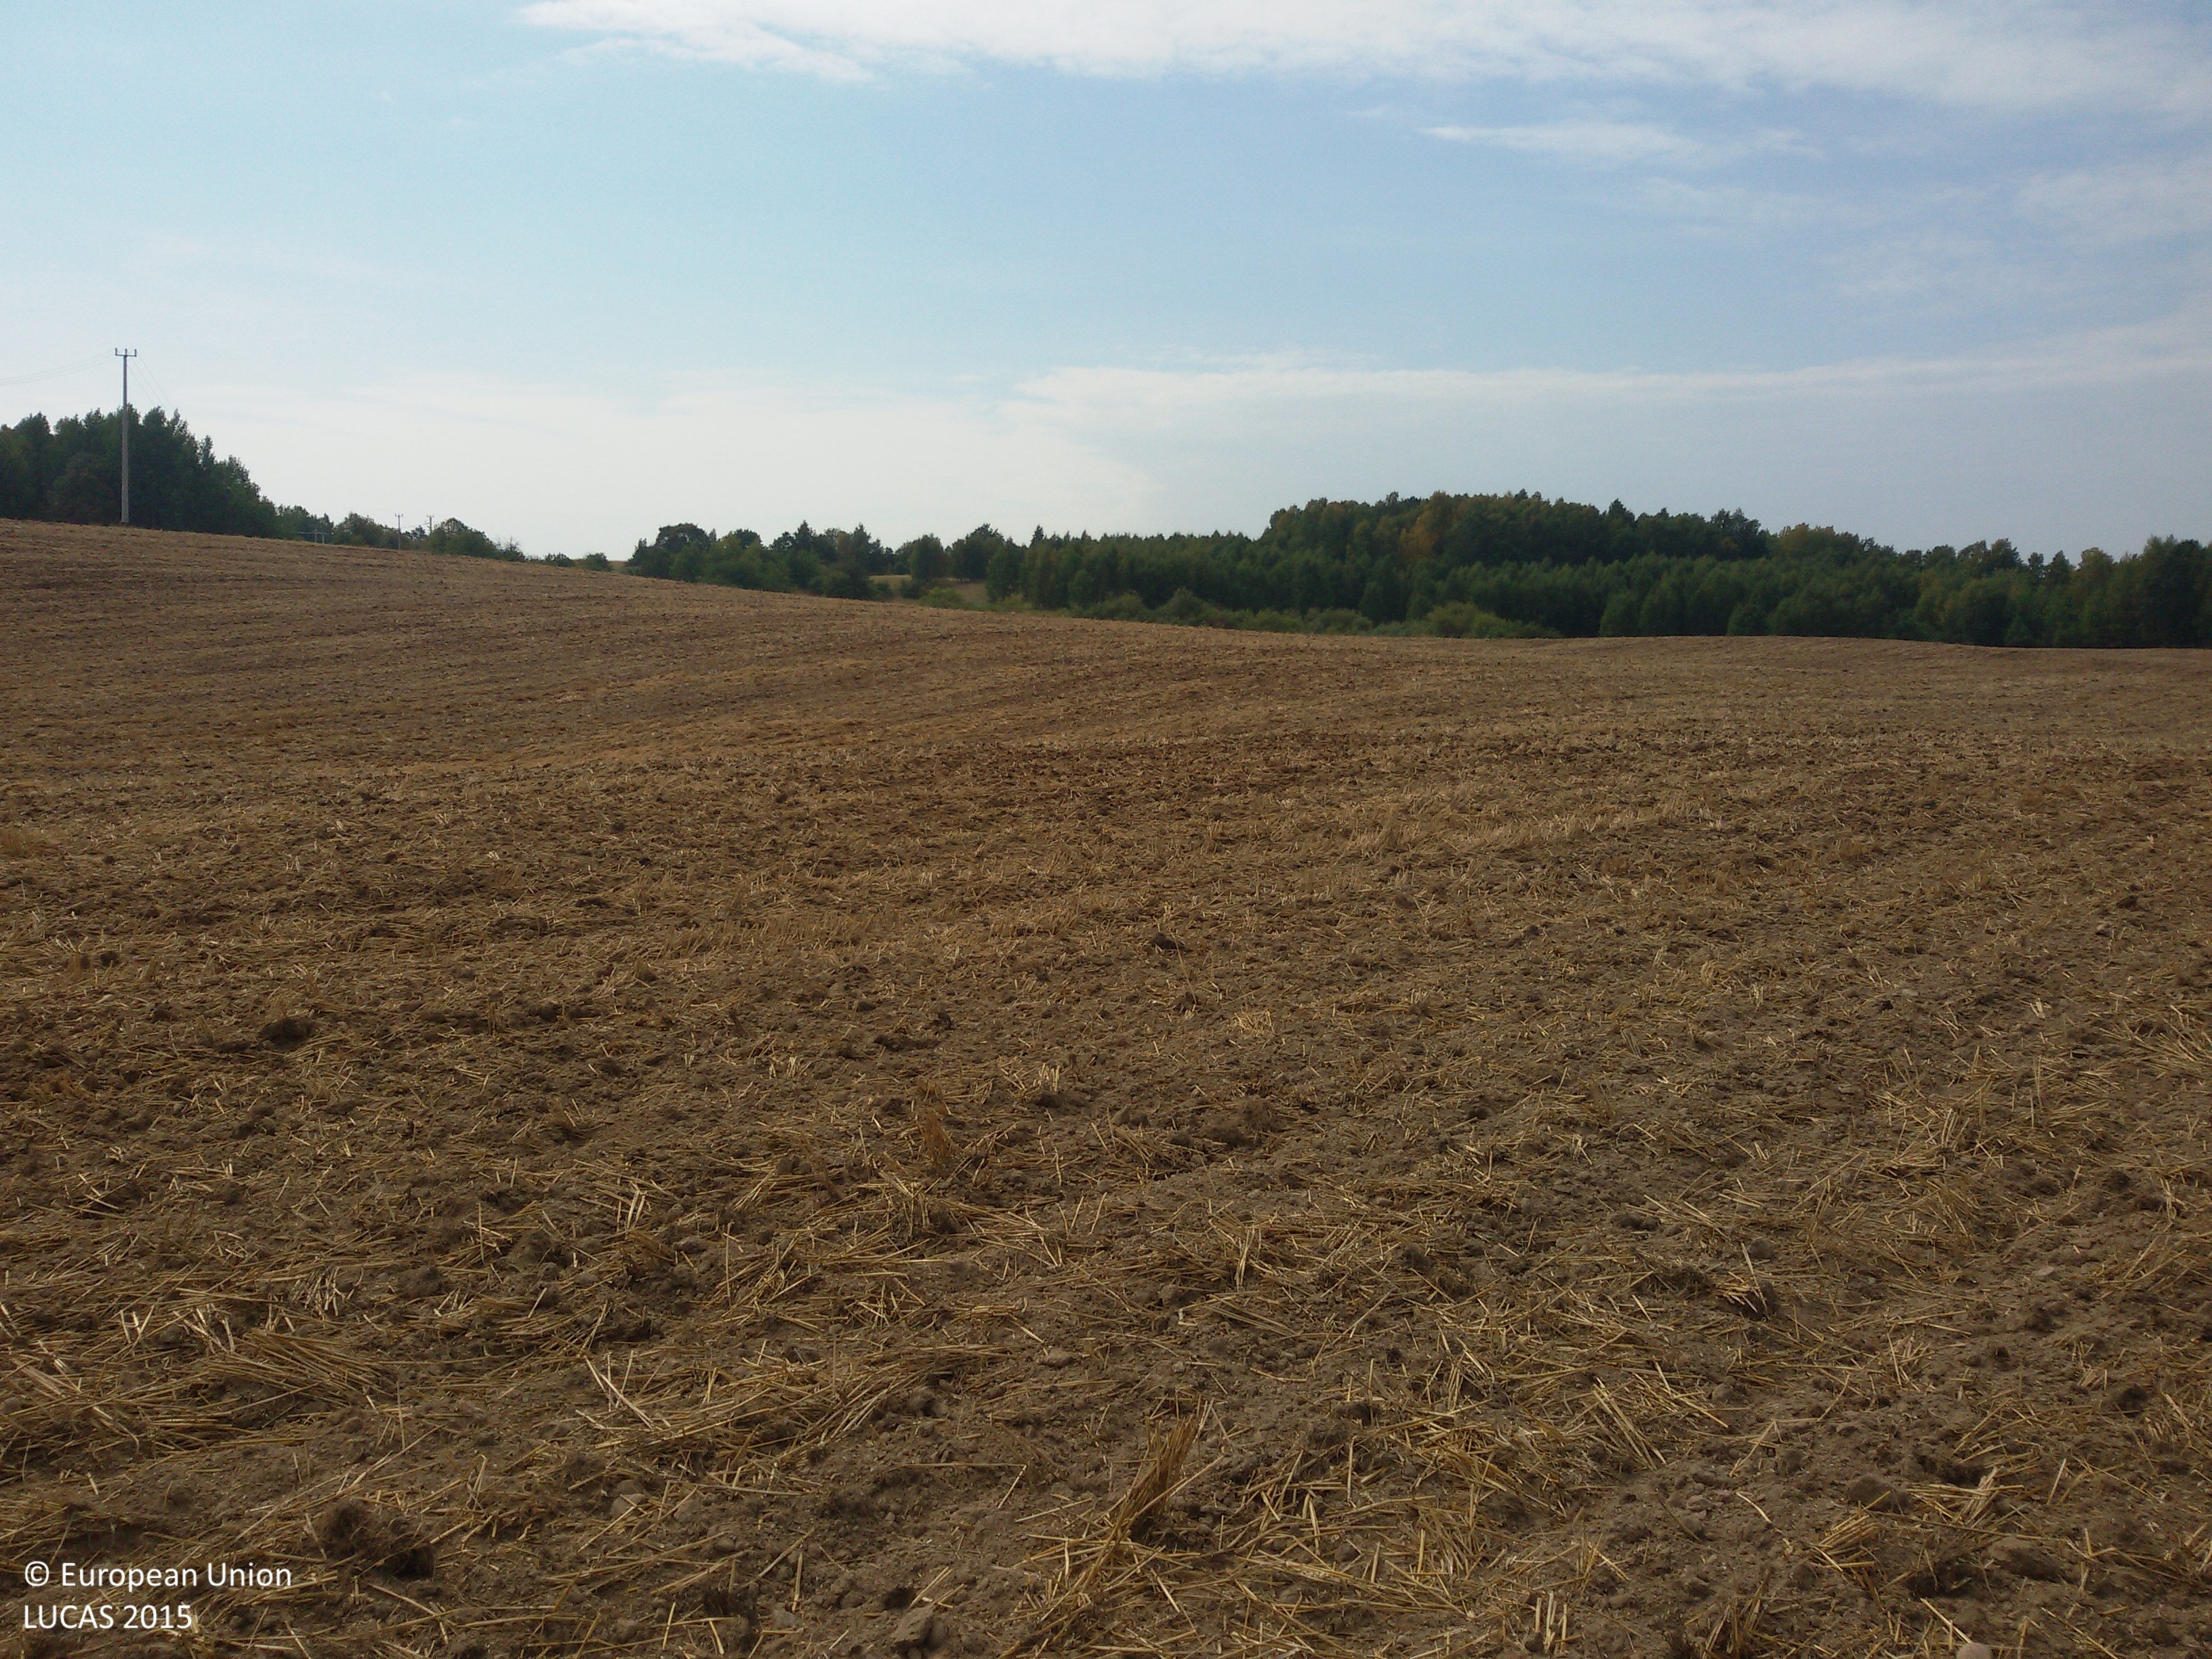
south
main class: Cropland
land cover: Common wheat
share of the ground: < 10 %
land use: Agriculture (excluding fallow land and kitchen gardens)
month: August
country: PL
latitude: 53.7257
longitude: 21.0931
